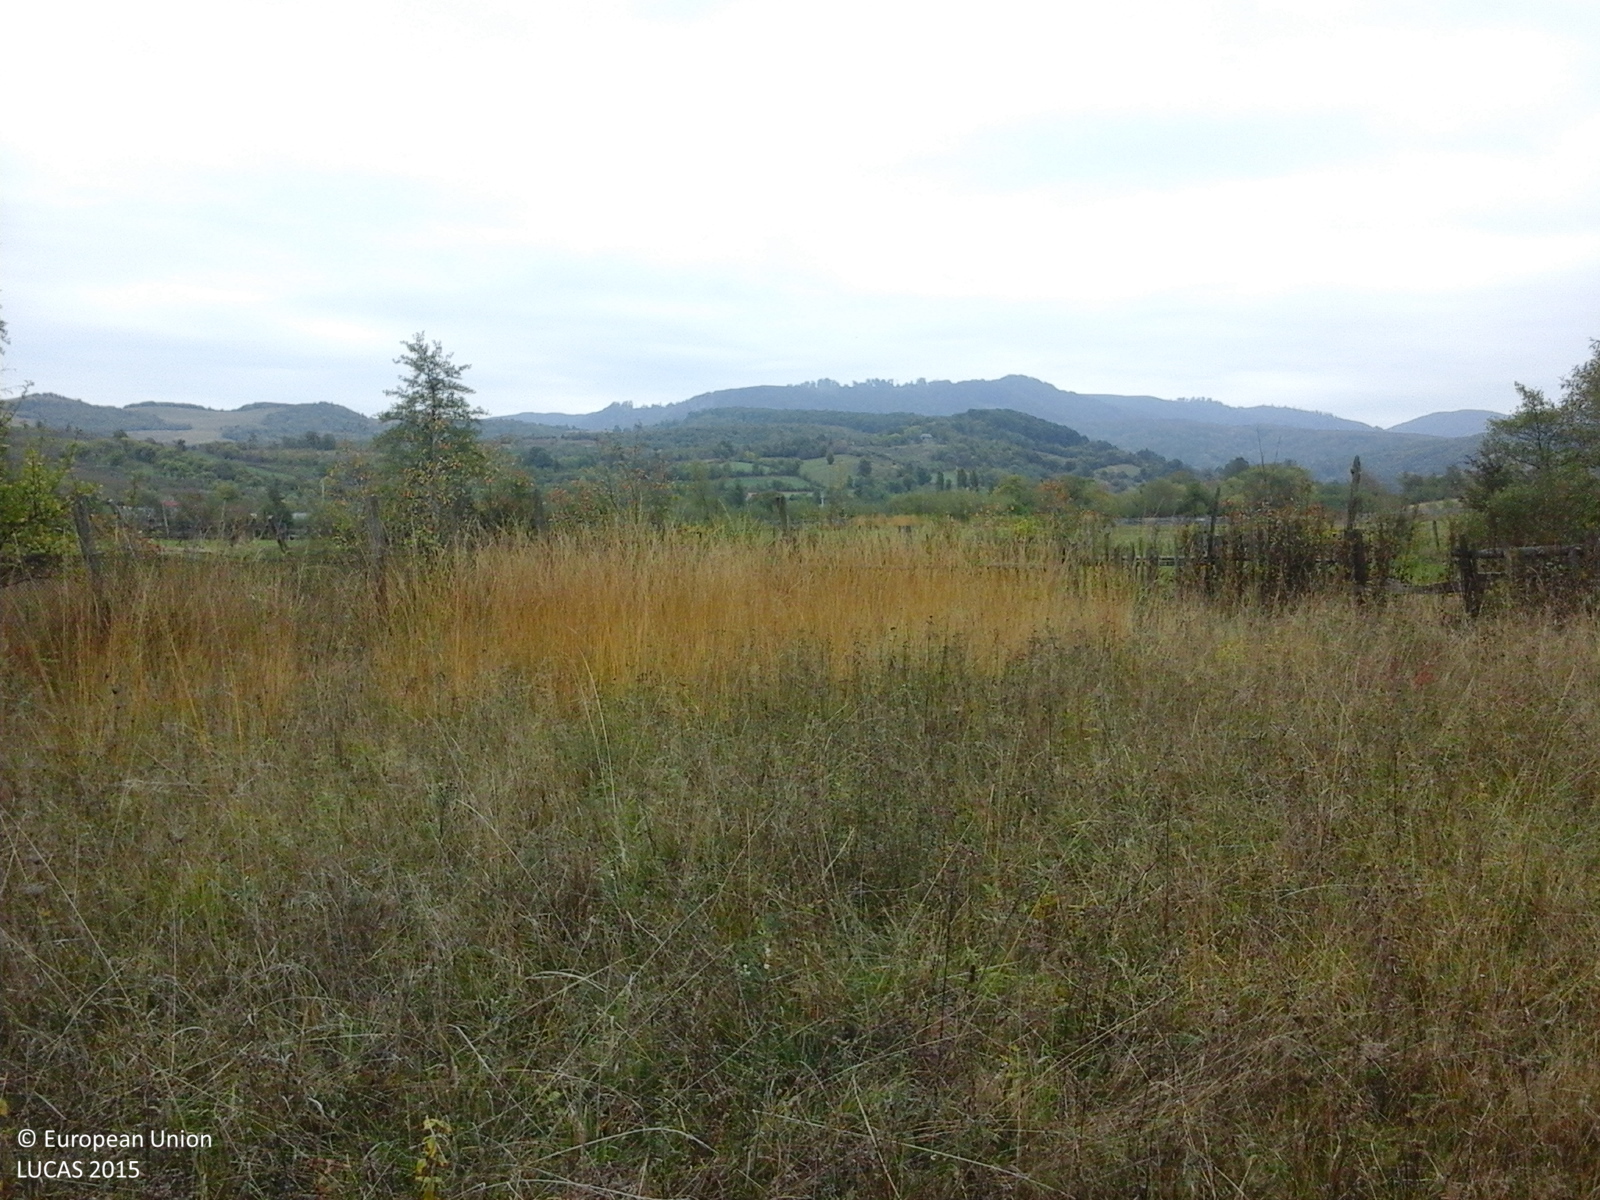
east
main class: Grassland
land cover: Spontaneously vegetated surfaces
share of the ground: > 75 %
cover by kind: herbaceous plants 100 %
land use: Fallow land
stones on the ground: < 10 %
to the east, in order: Spontaneously vegetated surfaces; Abandoned hedges; Fences; Grassland without tree/shrub cover; Abandoned hedges; Fences; Grassland without tree/shrub cover; Tracks; Grass margins; Spontaneously vegetated surfaces; Fences; Grassland without tree/shrub cover; Lines of trees; Fences; Other fruit trees and berries
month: October
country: RO
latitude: 46.7424
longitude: 24.9268
